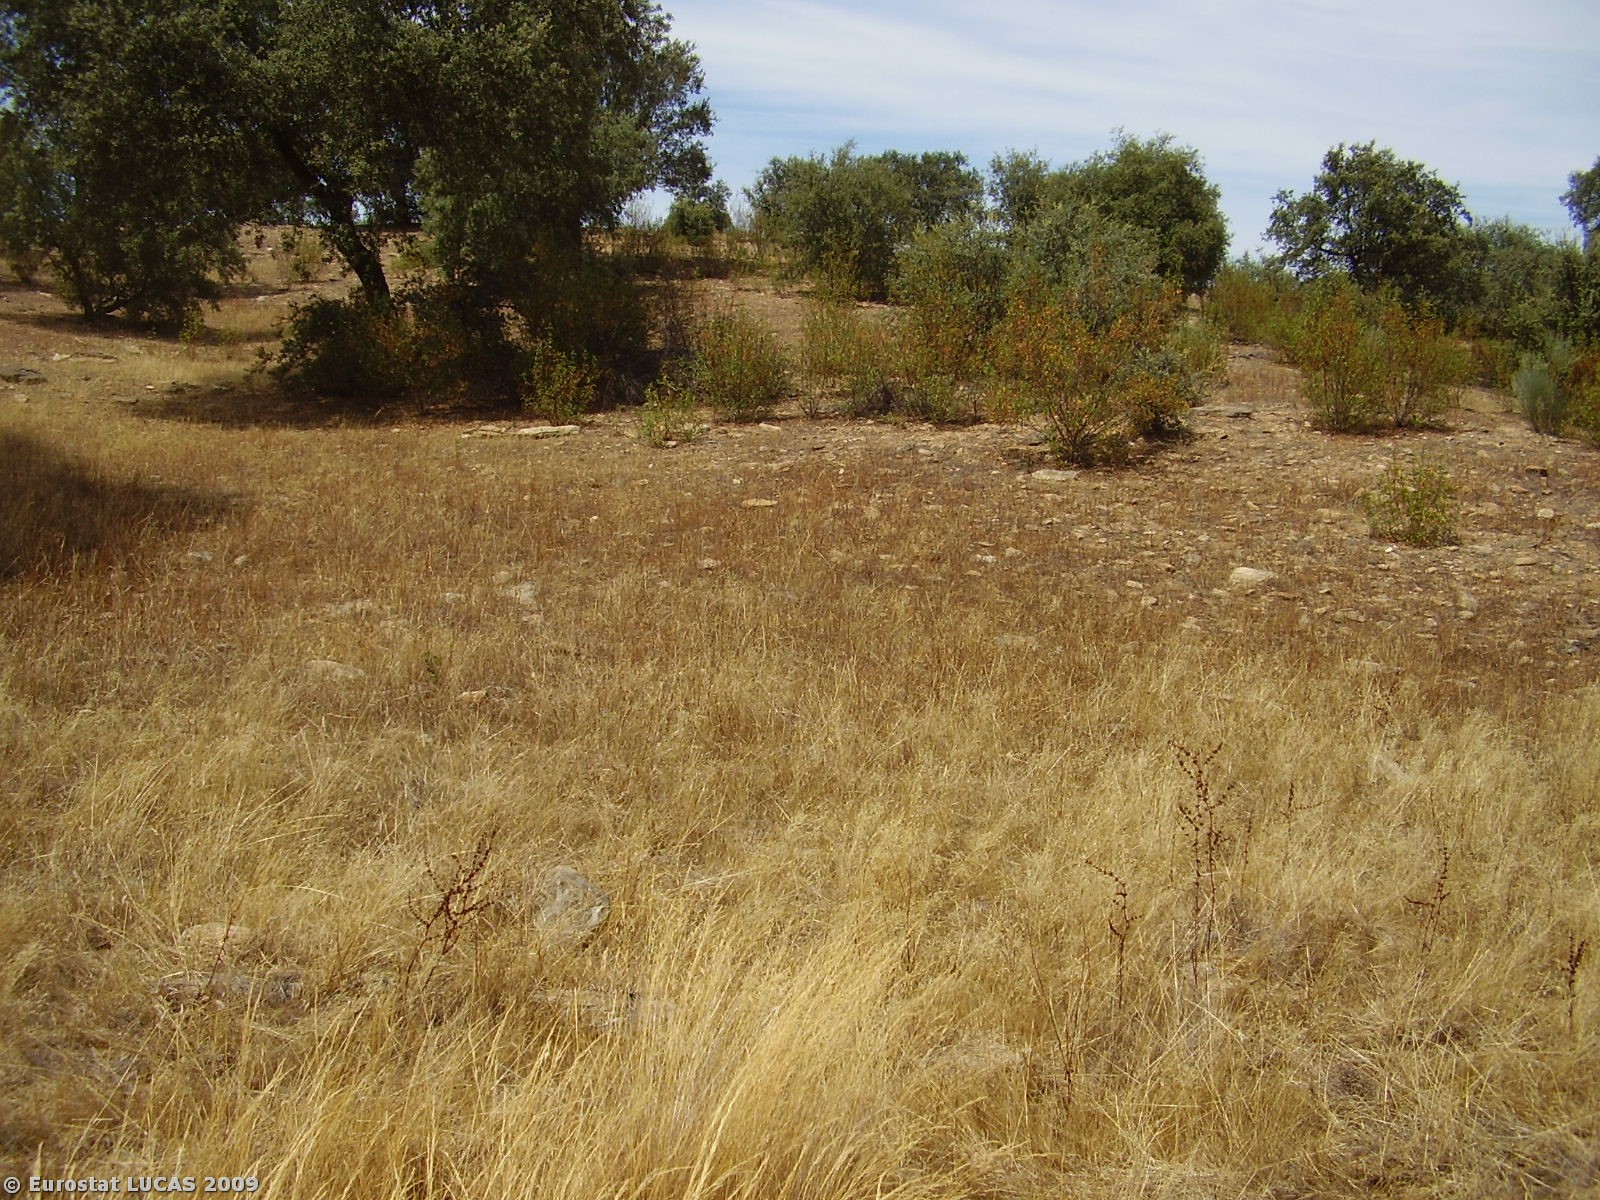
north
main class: Grassland
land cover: Grassland with sparse tree/shrub cover
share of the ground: > 75 %
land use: Forestry
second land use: Agriculture (excluding fallow land and kitchen gardens)
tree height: > 5 m
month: July
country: PT
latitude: 38.5665
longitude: -7.8150
